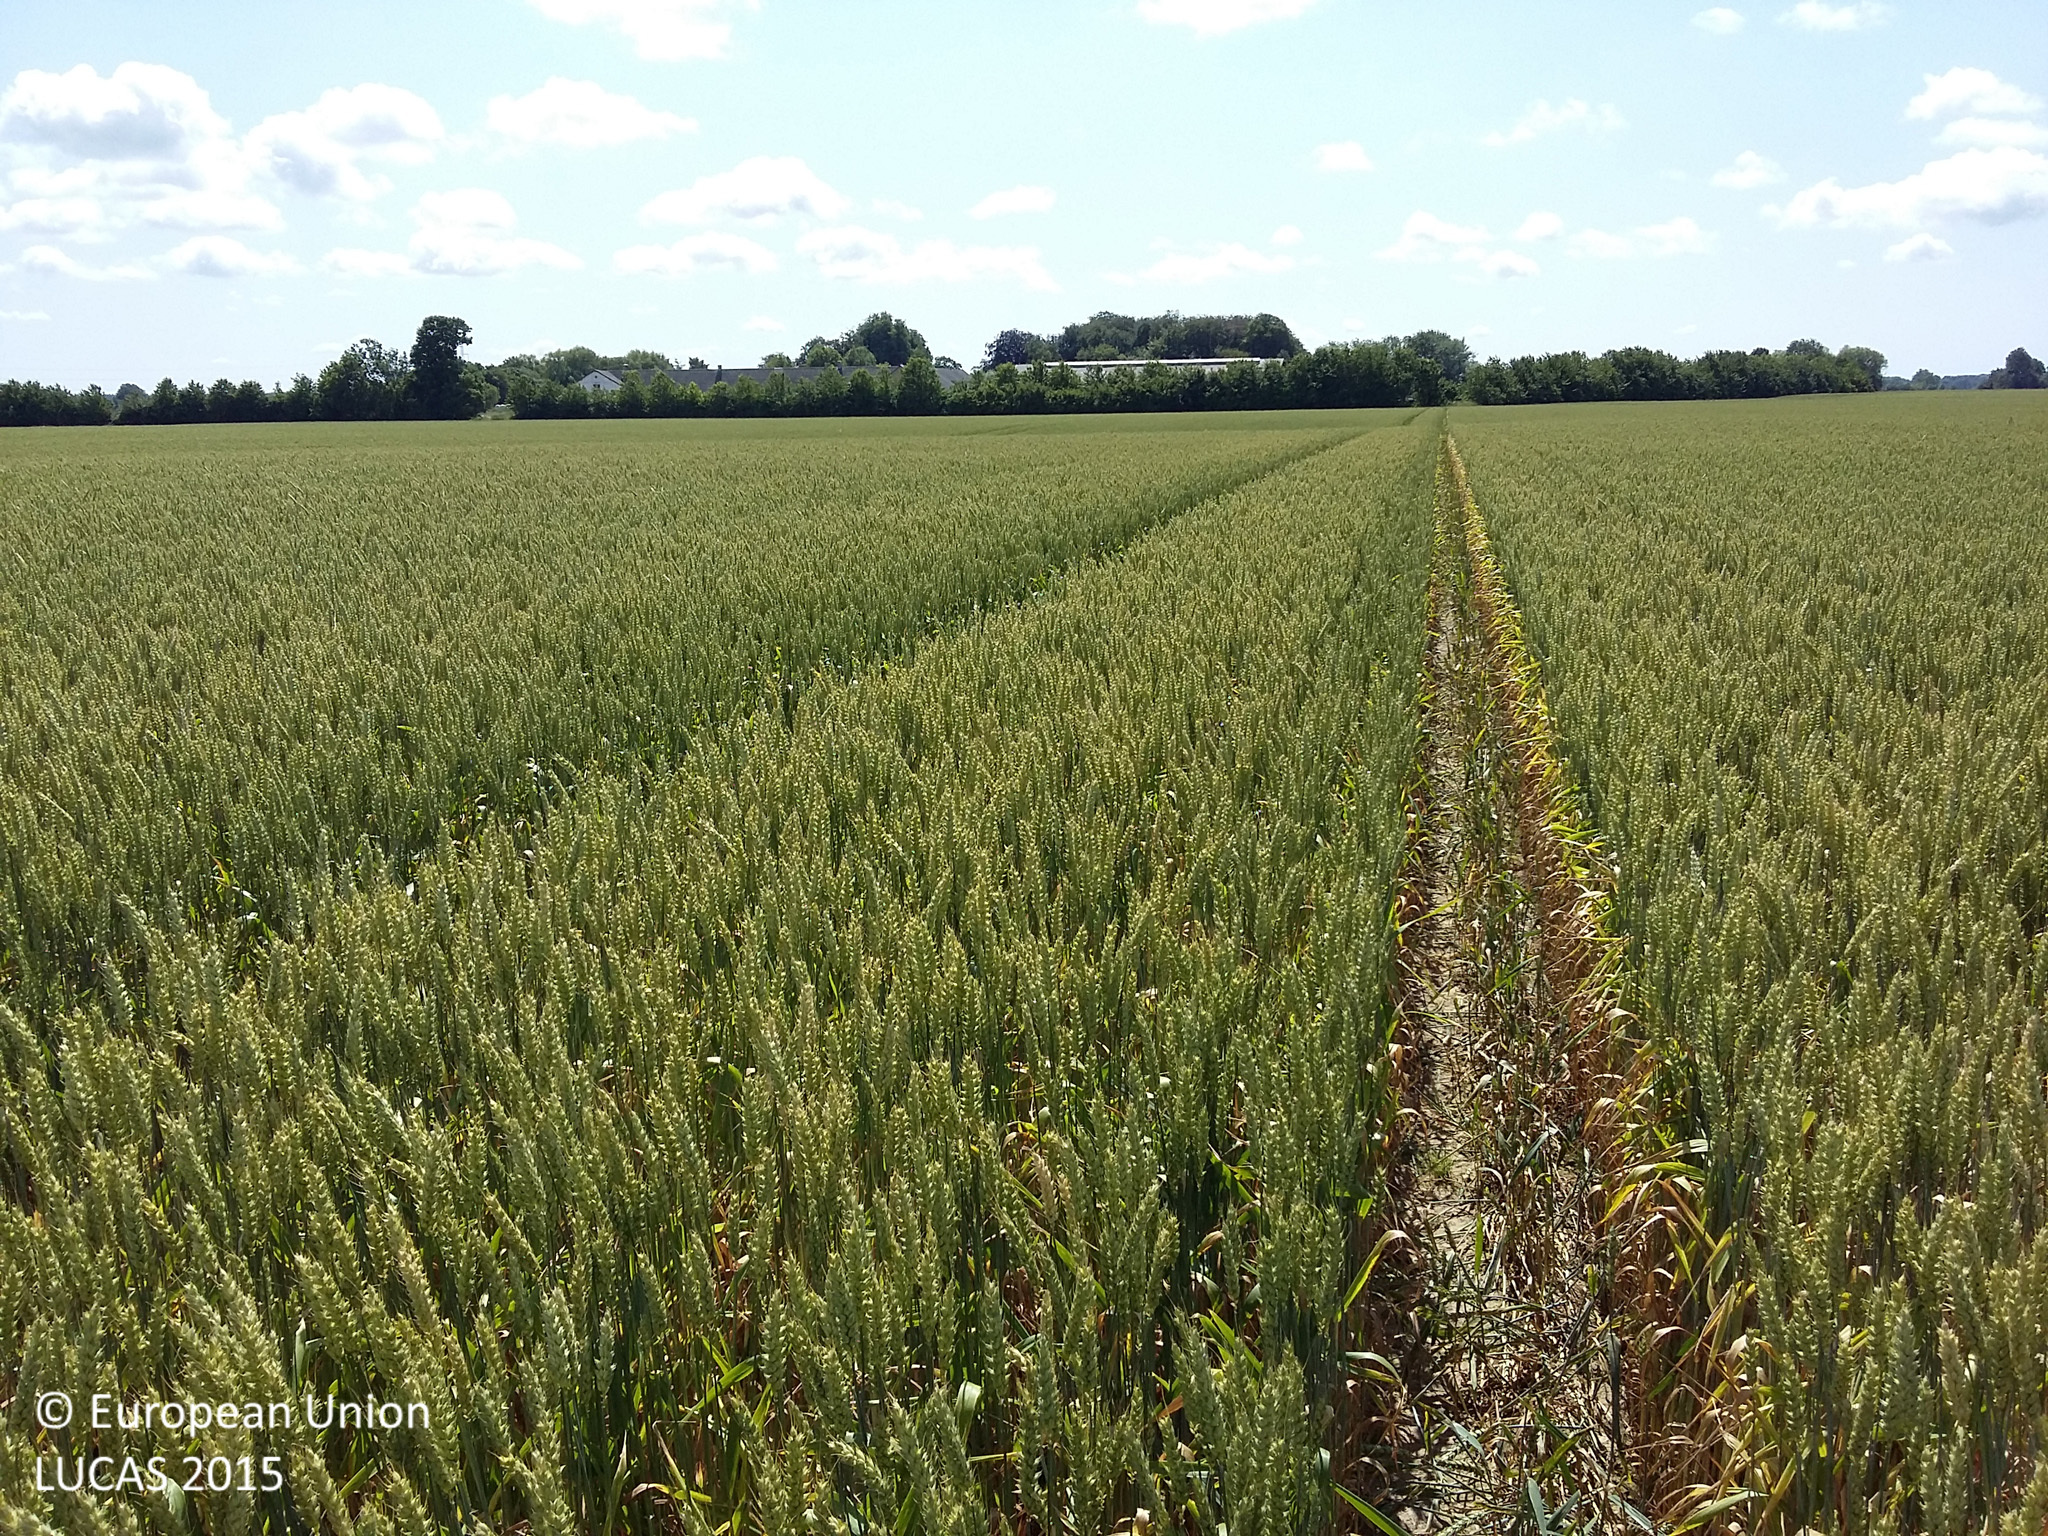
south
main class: Cropland
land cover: Common wheat
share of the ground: > 75 %
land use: Agriculture (excluding fallow land and kitchen gardens)
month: July
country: DK
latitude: 55.5138
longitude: 11.5031
